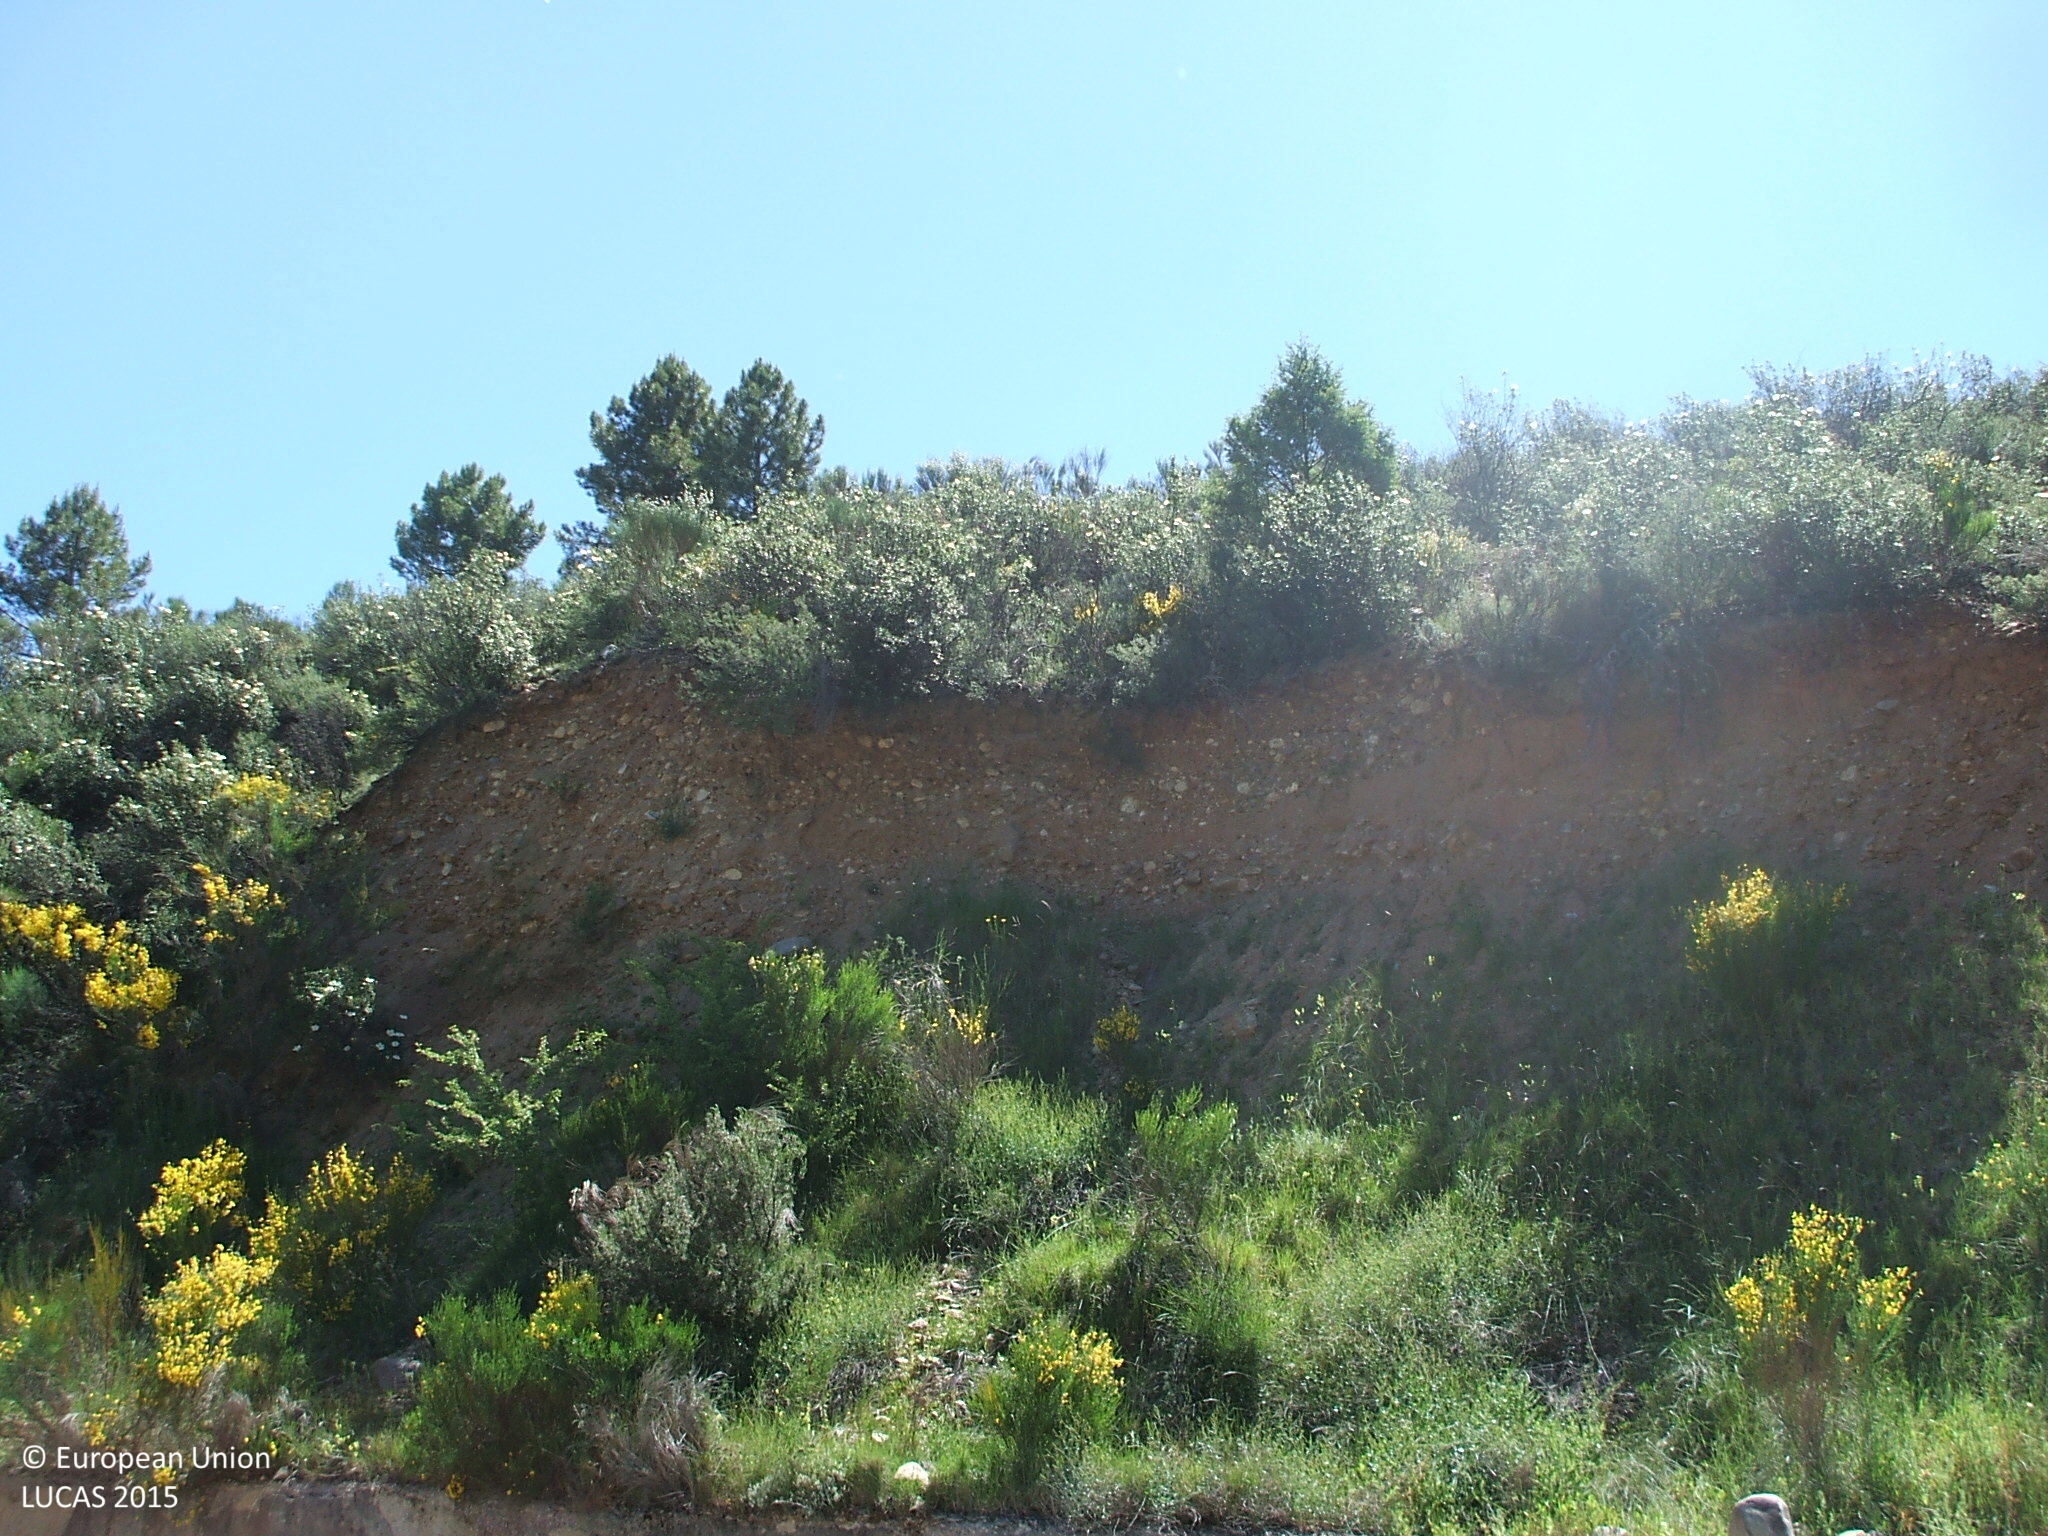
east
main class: Shrubland
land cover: Shrubland without tree cover
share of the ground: > 75 %
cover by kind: shrubs 100 %
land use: Semi-natural and natural areas not in use
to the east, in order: Shrubland without tree cover; Rivers and streams; Shrubland without tree cover
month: May
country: ES
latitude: 40.8972
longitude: -3.4173
